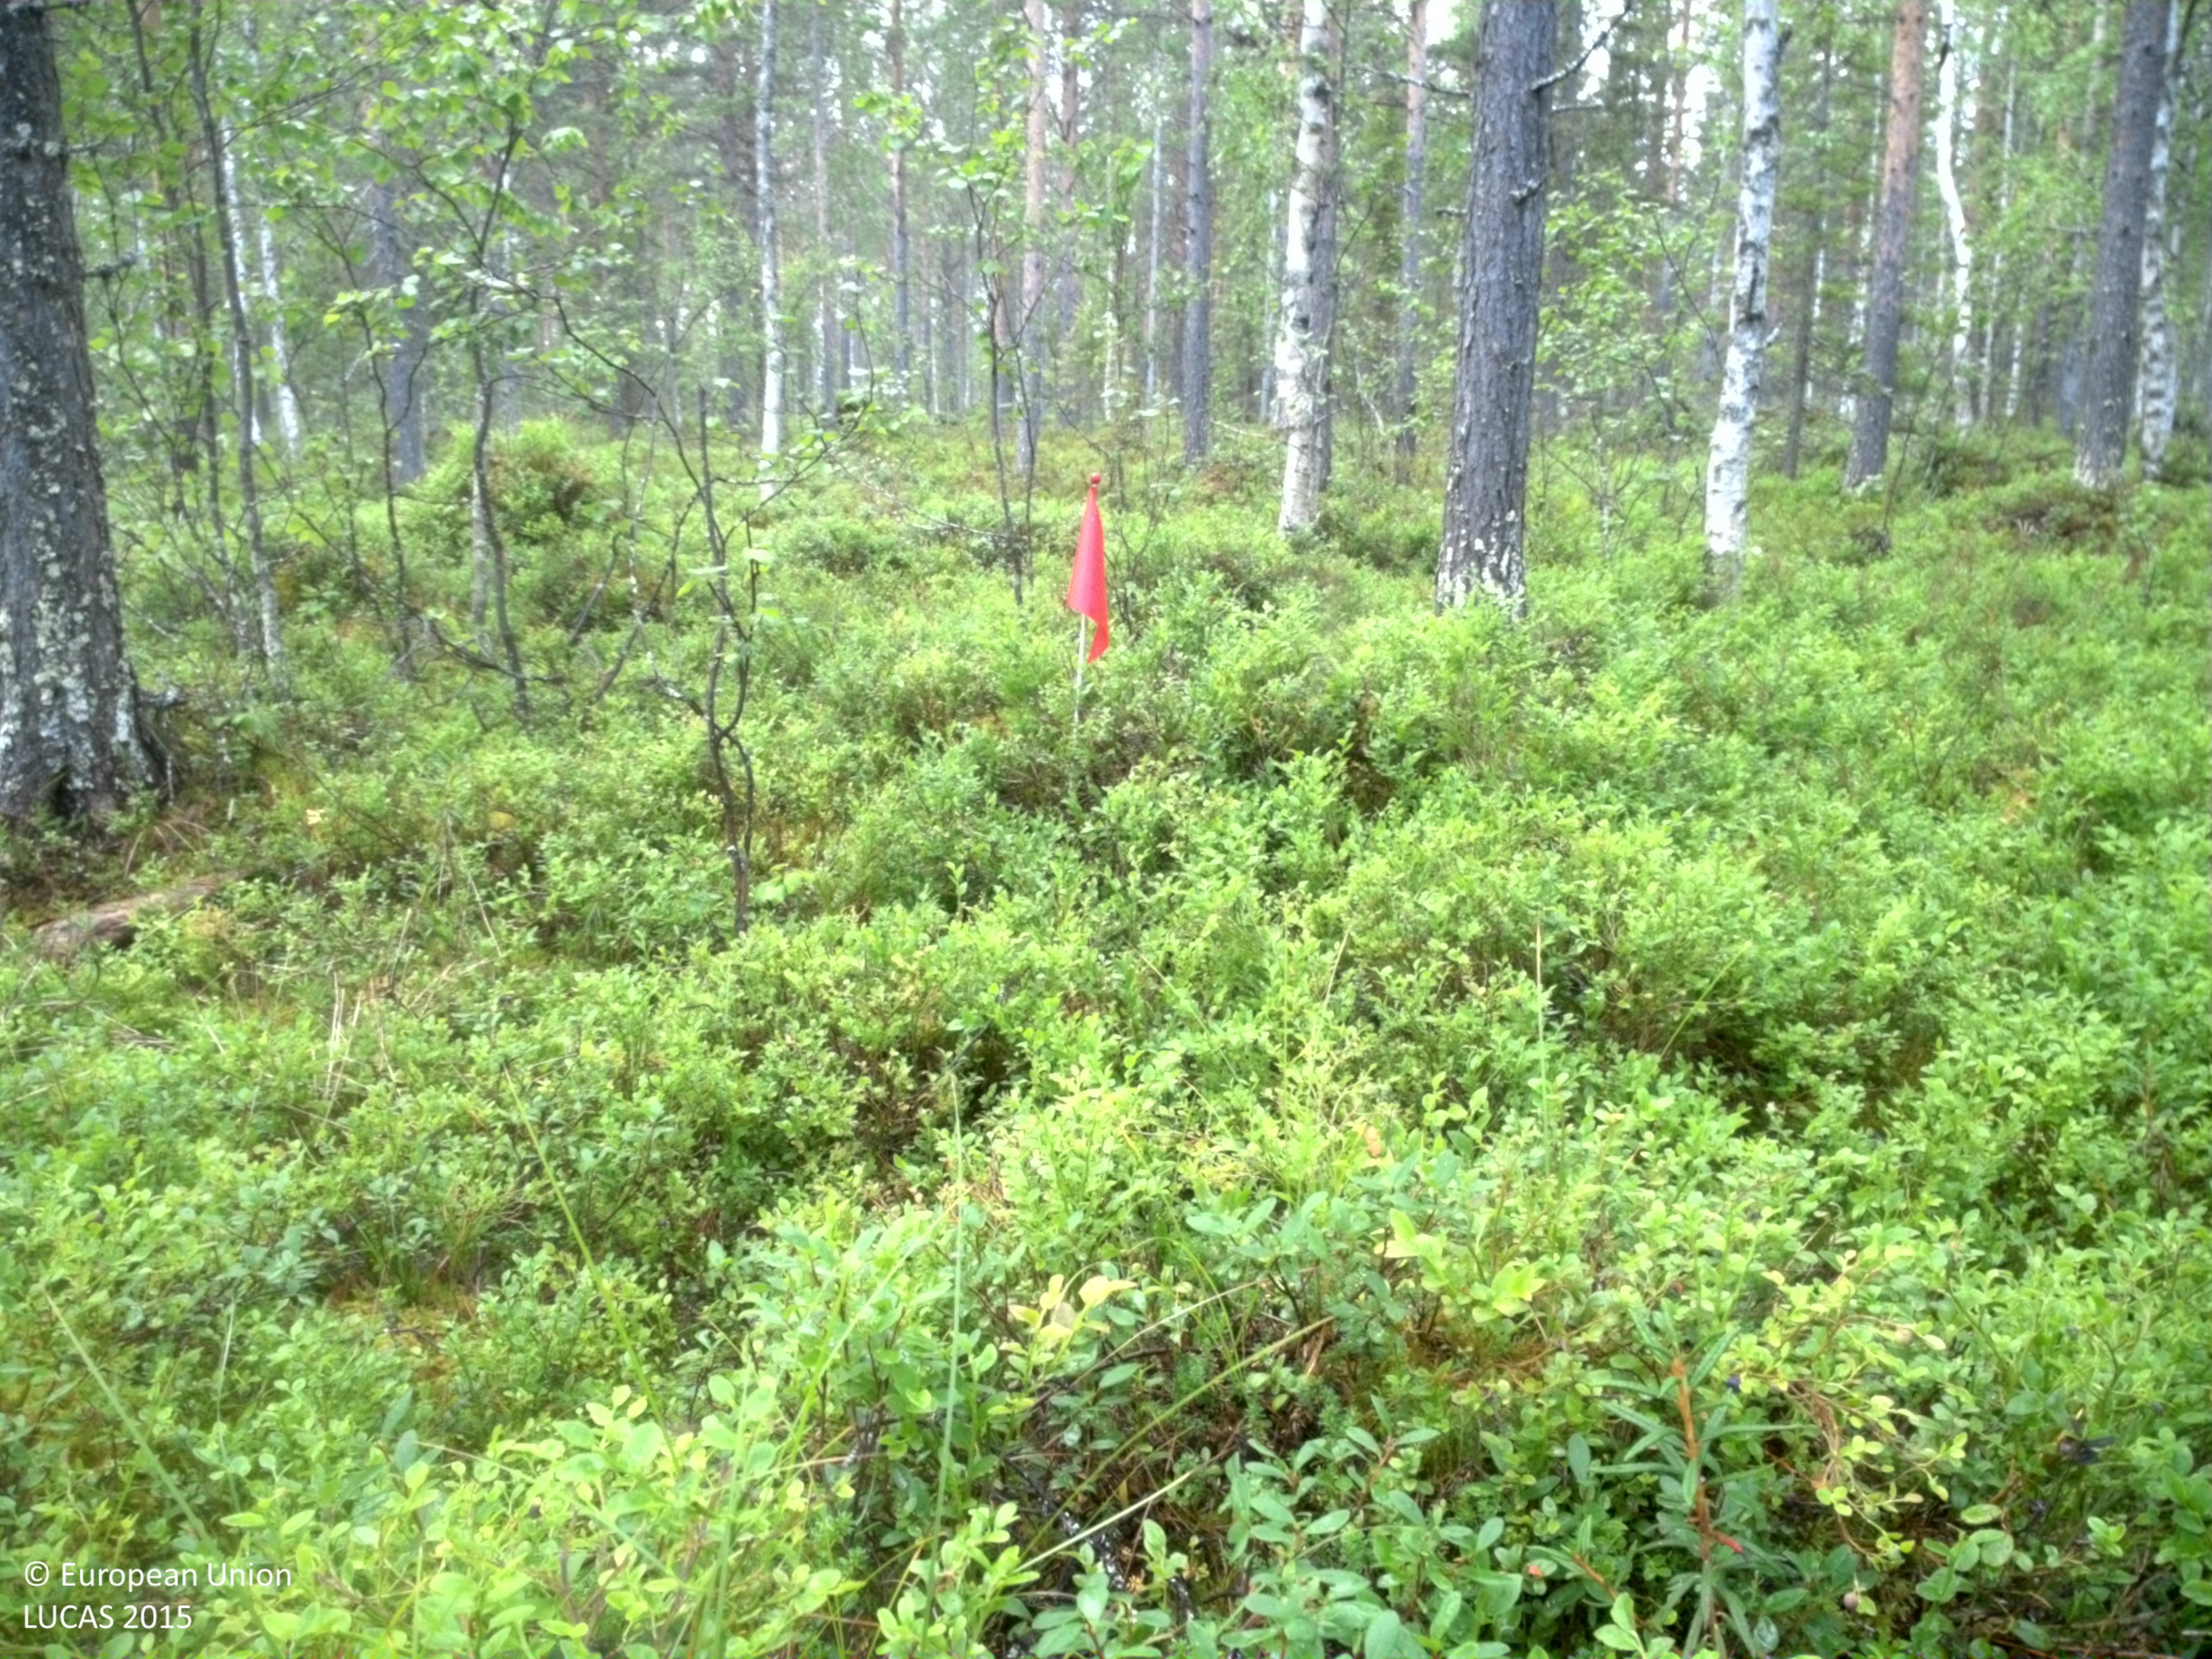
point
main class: Woodland
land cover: Pine dominated coniferous woodland
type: boreal forest
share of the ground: 25 - 50 %
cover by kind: shrubs 60 %, coniferous forest trees 30 %, broadleaved forest trees 5 %, lichens and mosses 5 %
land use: Forestry
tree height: > 5 m
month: July
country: SE
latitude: 66.1532
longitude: 20.4444
